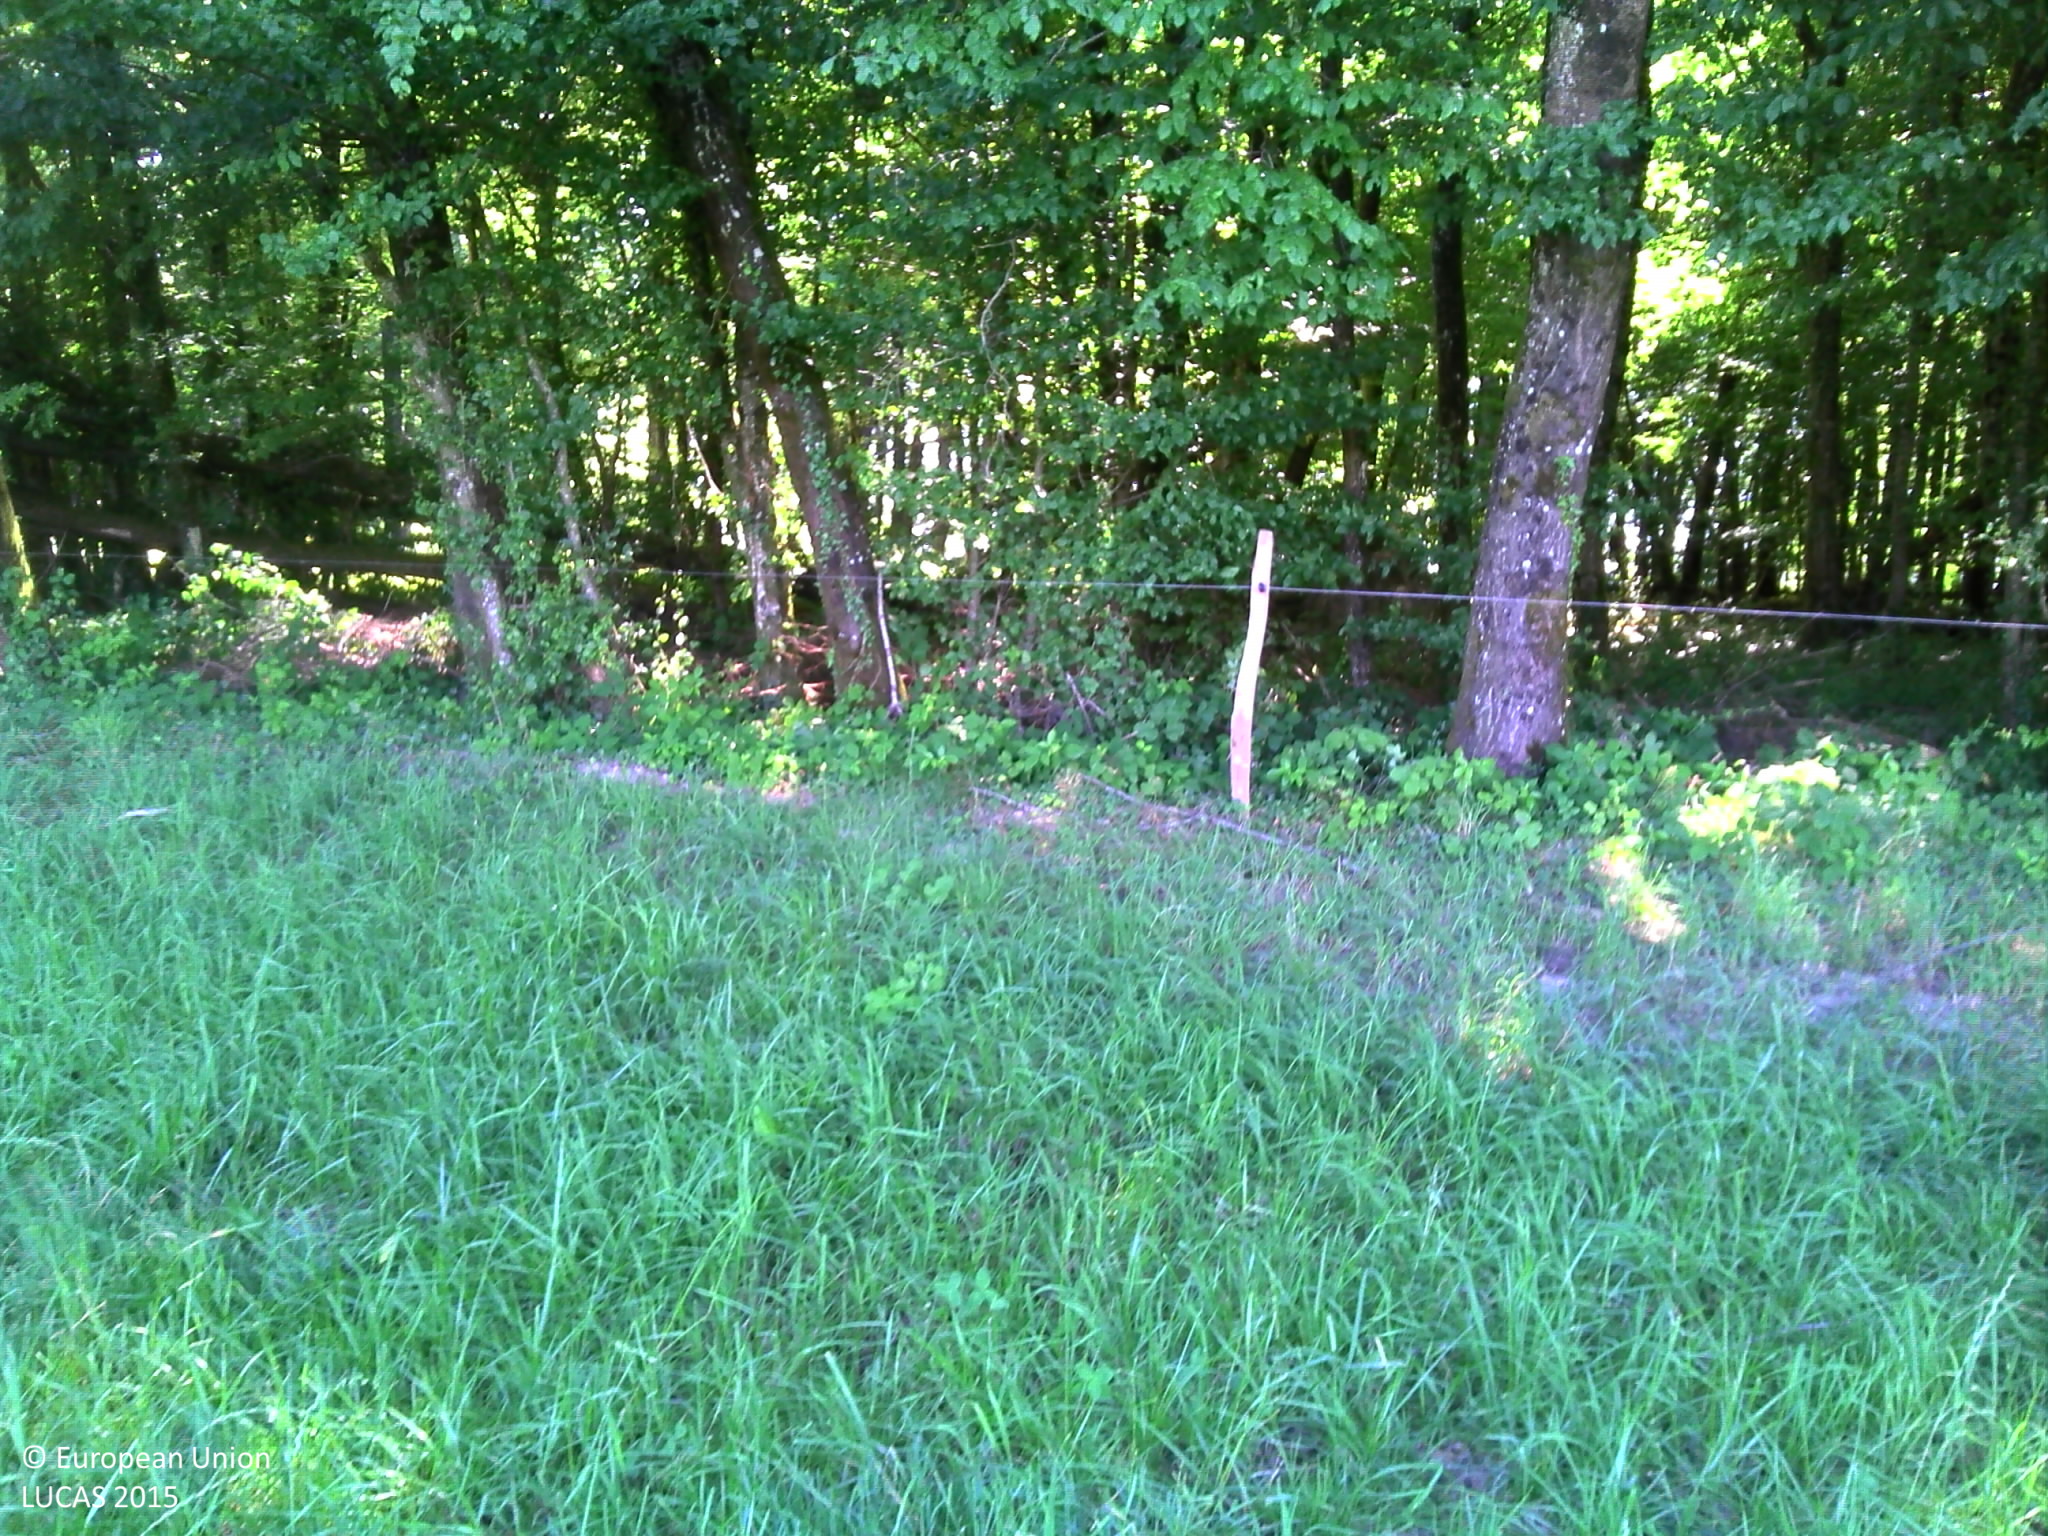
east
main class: Cropland
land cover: Temporary grasslands
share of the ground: > 75 %
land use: Agriculture (excluding fallow land and kitchen gardens)
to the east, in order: Temporary grasslands; Fences; Broadleaved woodland; Spontaneously vegetated surfaces; Tracks; Broadleaved woodland
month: June
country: FR
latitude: 47.4534
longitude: 6.1418
